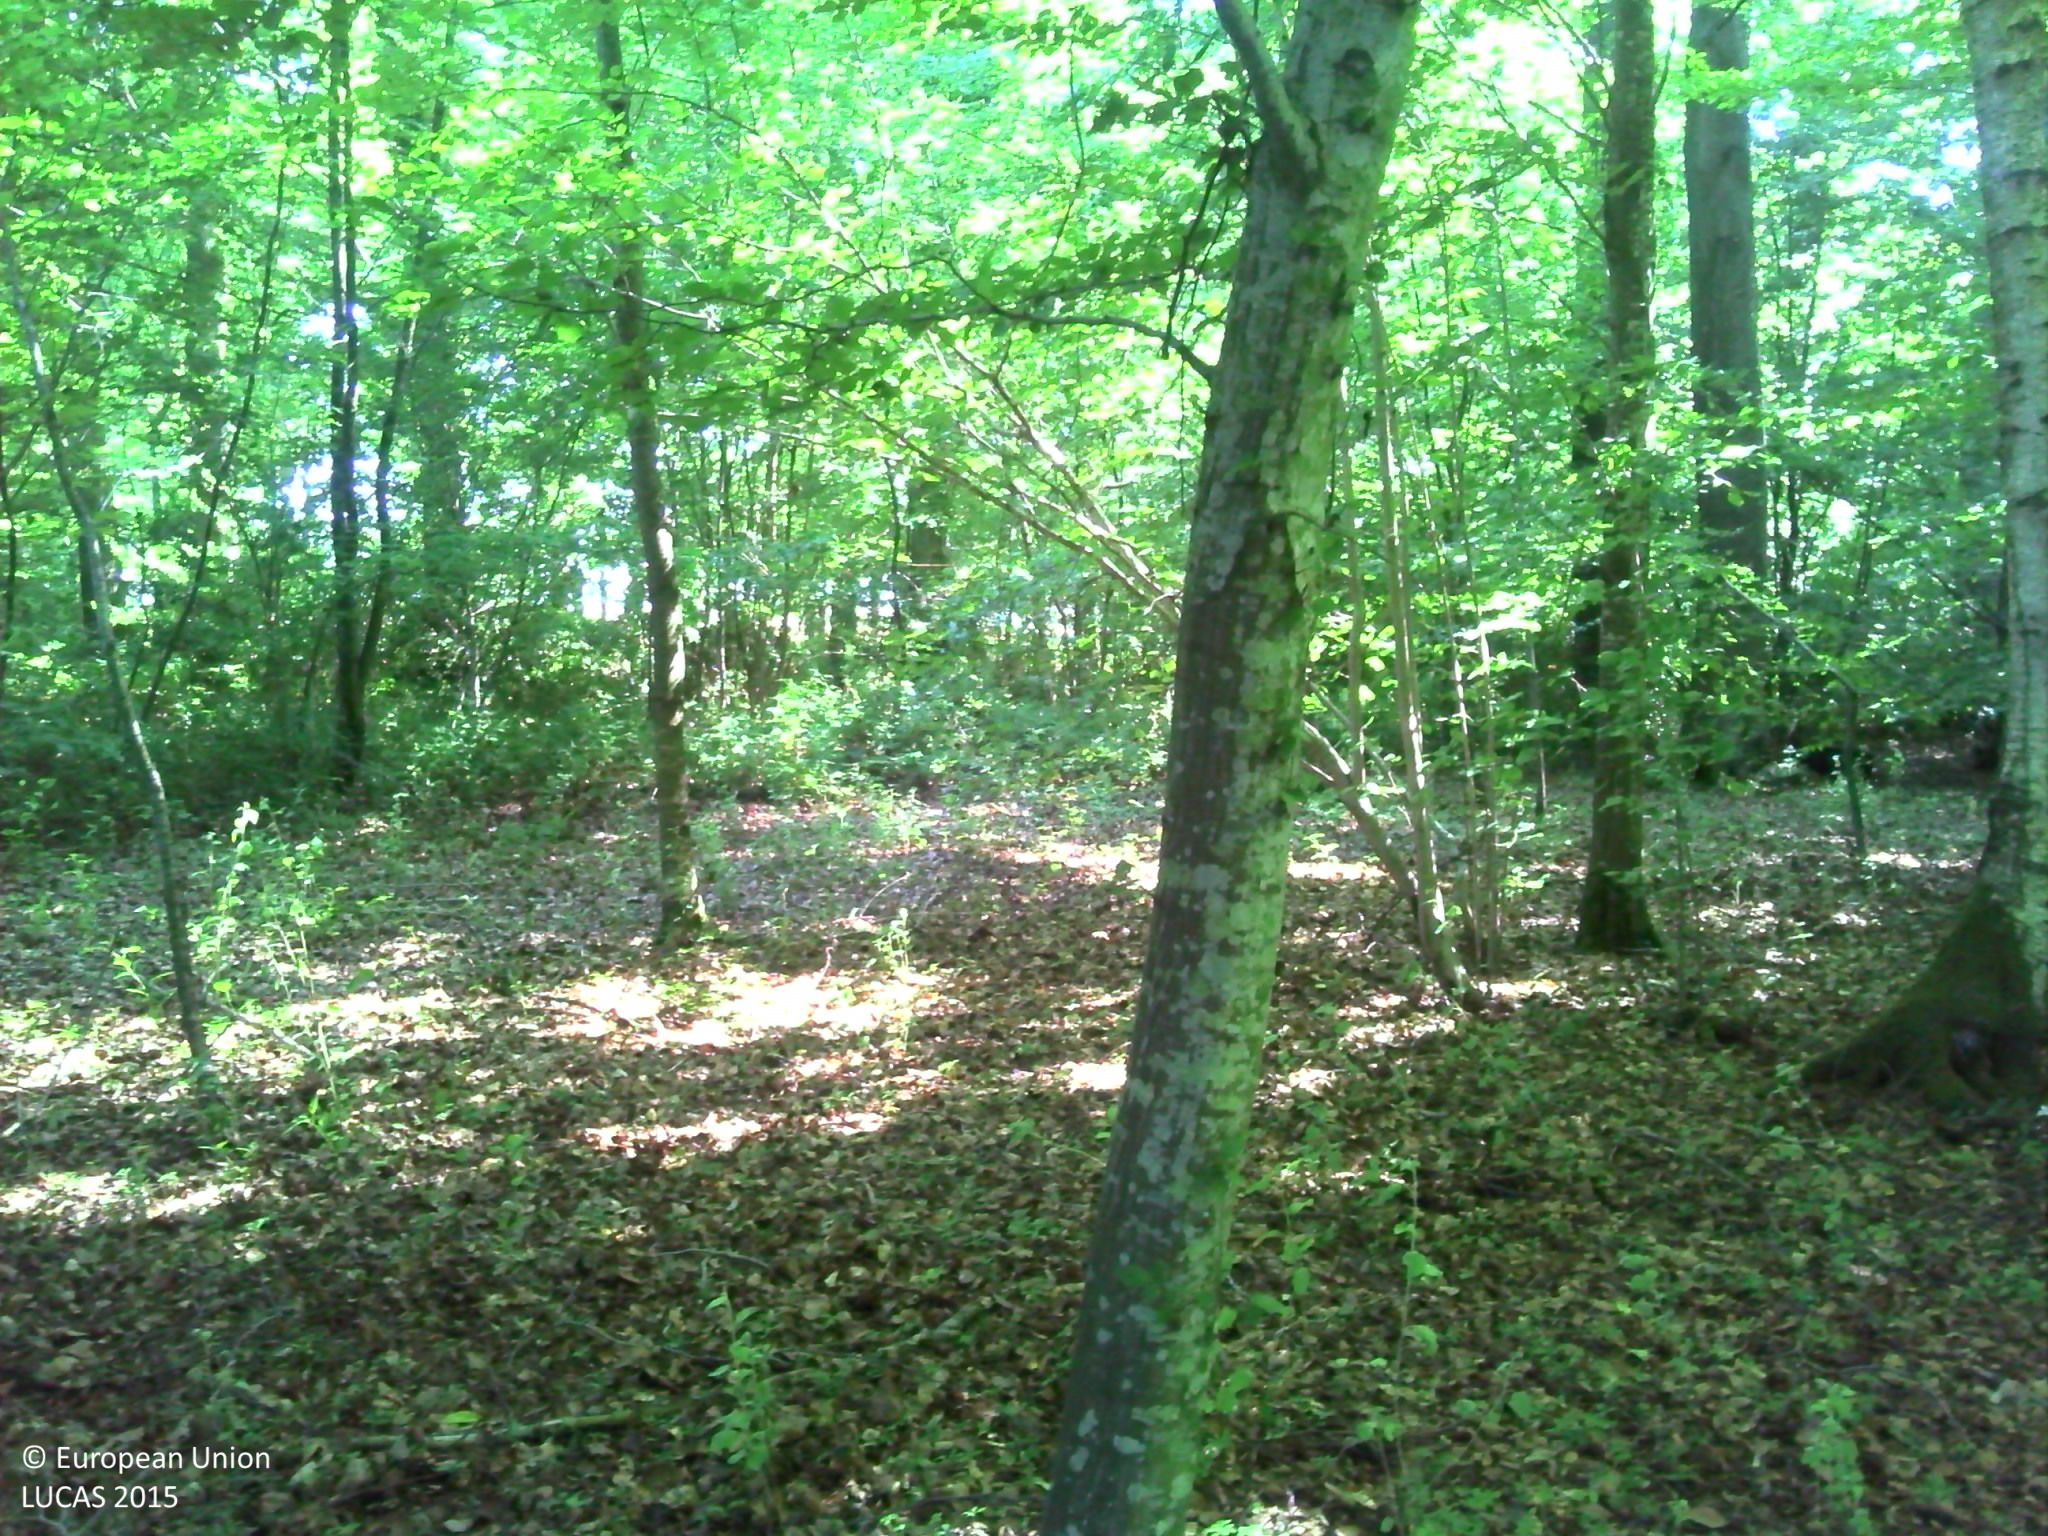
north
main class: Woodland
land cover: Broadleaved woodland
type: mesophytic deciduous forest
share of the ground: > 75 %
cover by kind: broadleaved forest trees 80 %, consolidated bare surface 10 %, coniferous forest trees 5 %, herbaceous plants 5 %
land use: Forestry
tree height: > 5 m
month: July
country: FR
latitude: 49.0080
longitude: 0.5000
